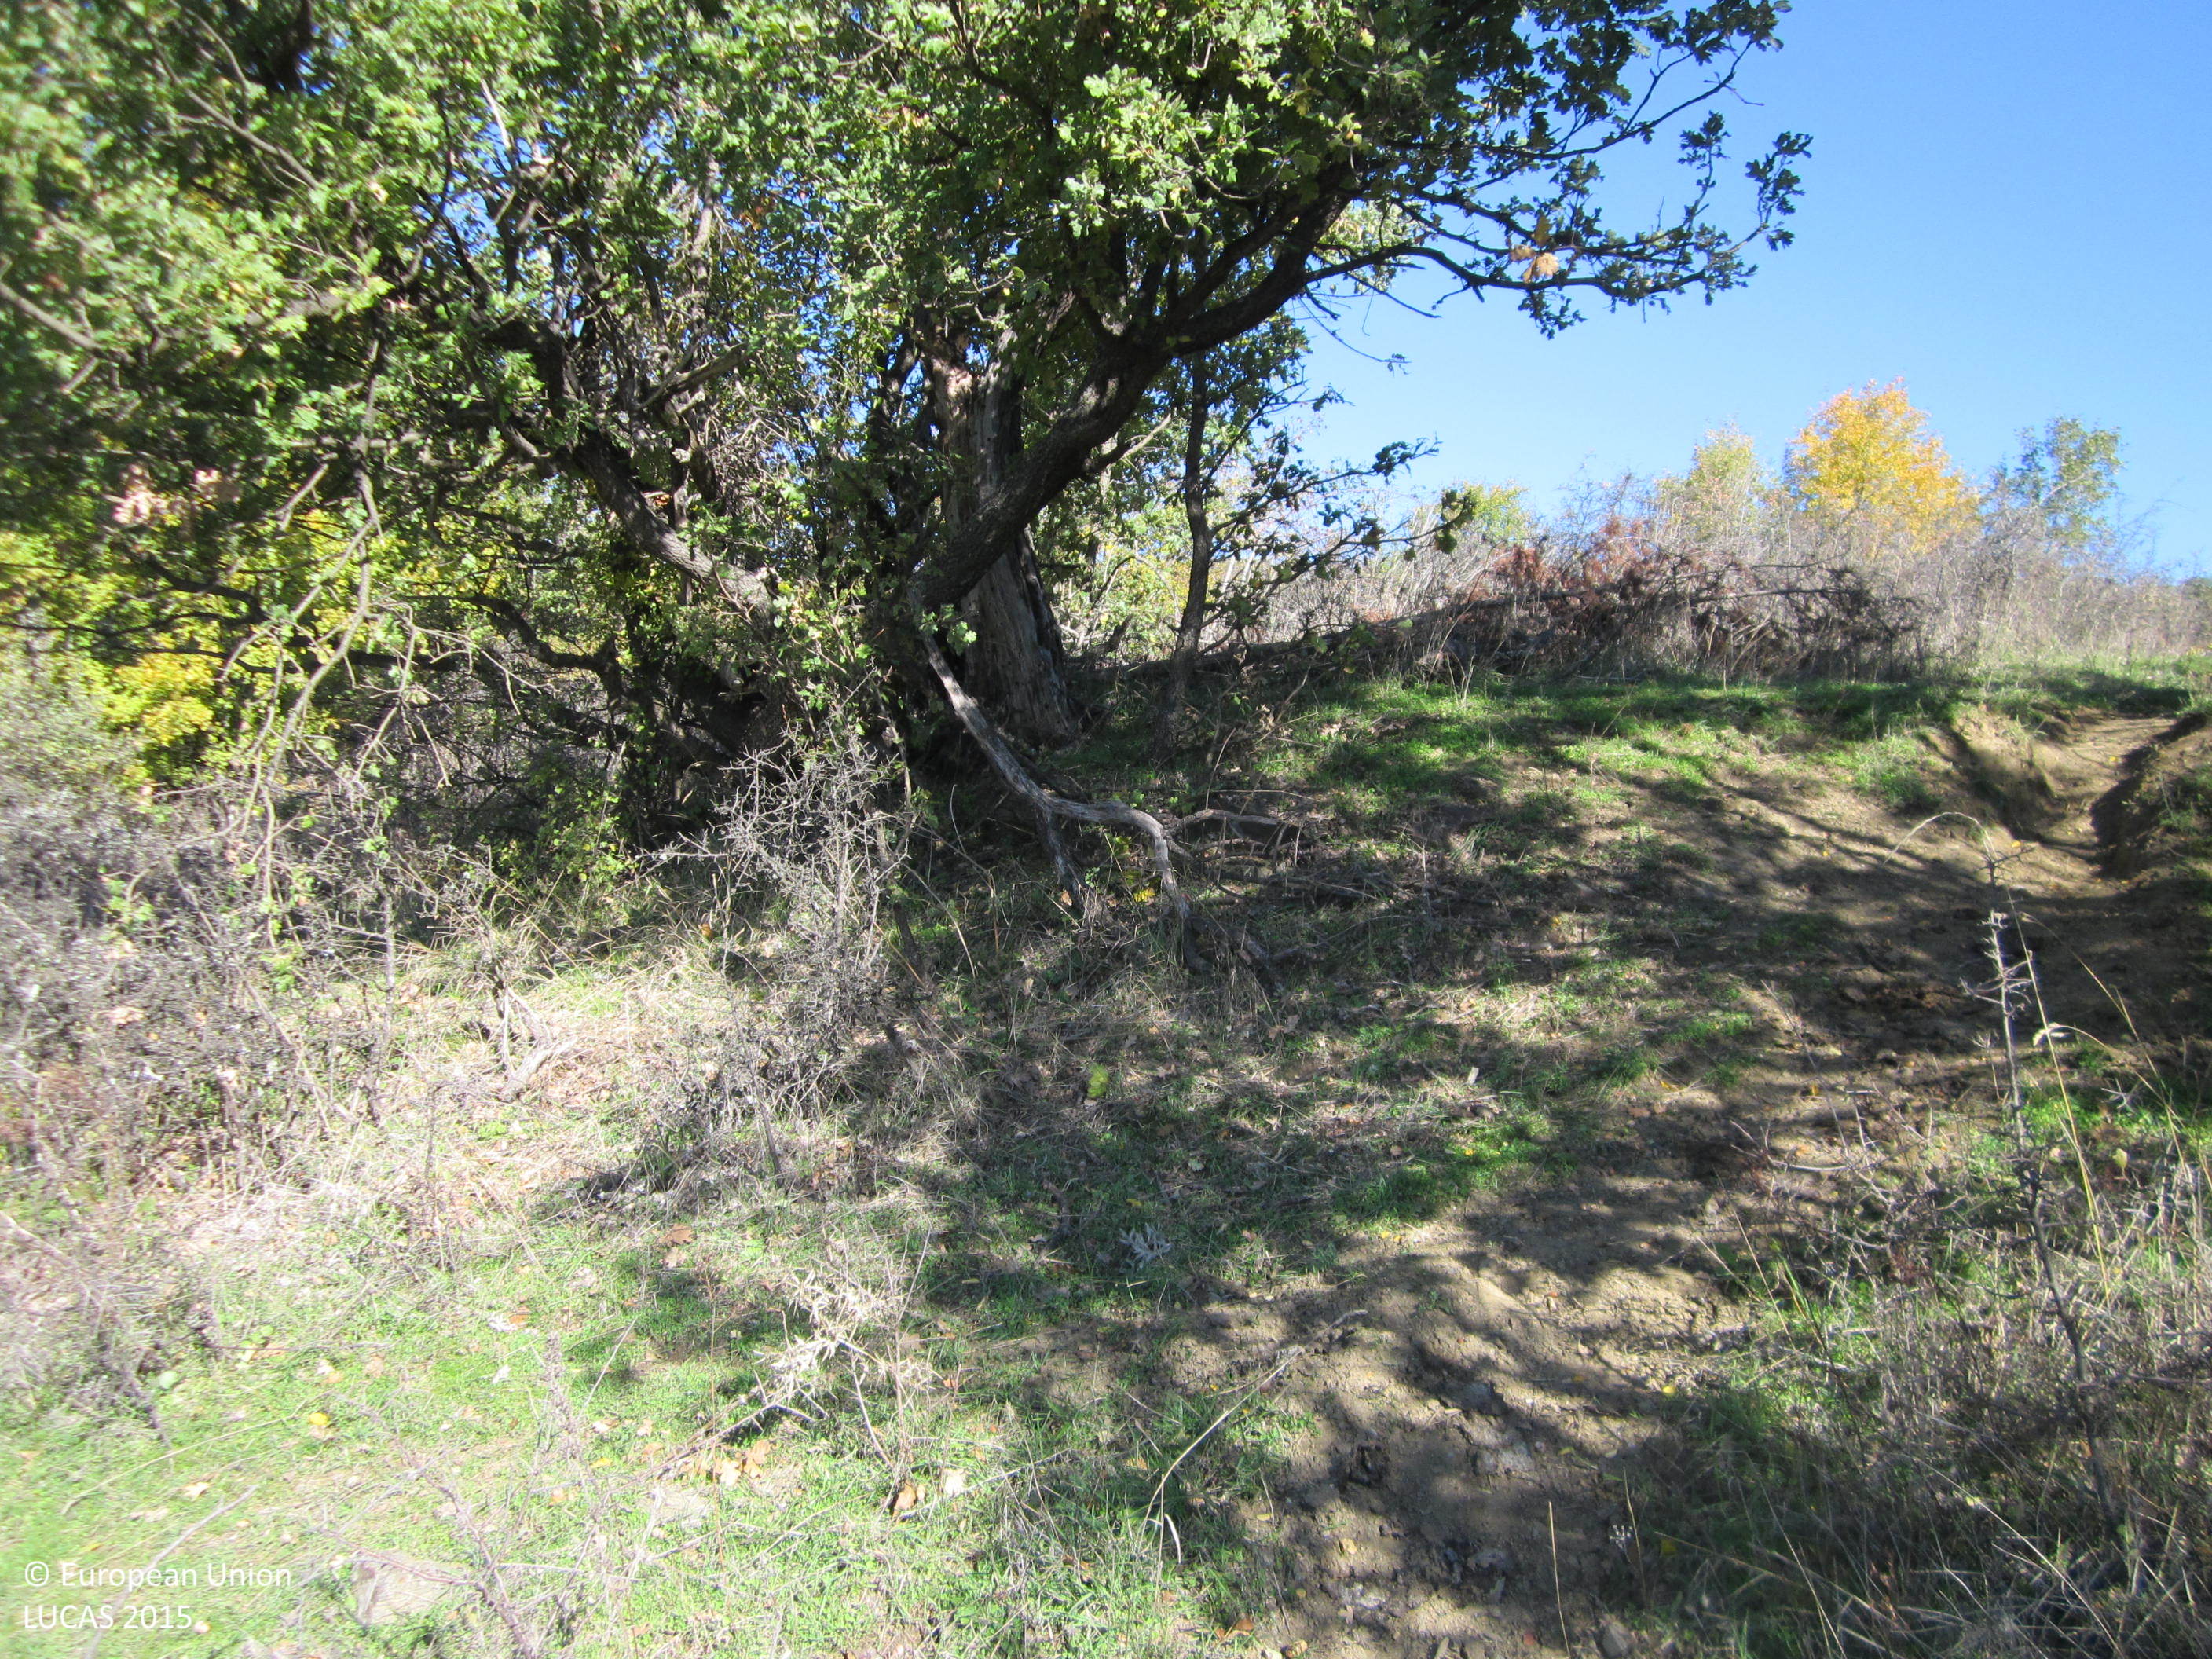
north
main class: Woodland
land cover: Broadleaved woodland
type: hemiboreal forest and nemoral coniferous forest and mixed broadleaved-coniferous forest
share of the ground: > 75 %
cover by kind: broadleaved forest trees 100 %
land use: Forestry
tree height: > 5 m
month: November
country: BG
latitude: 41.4337
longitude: 25.8485
